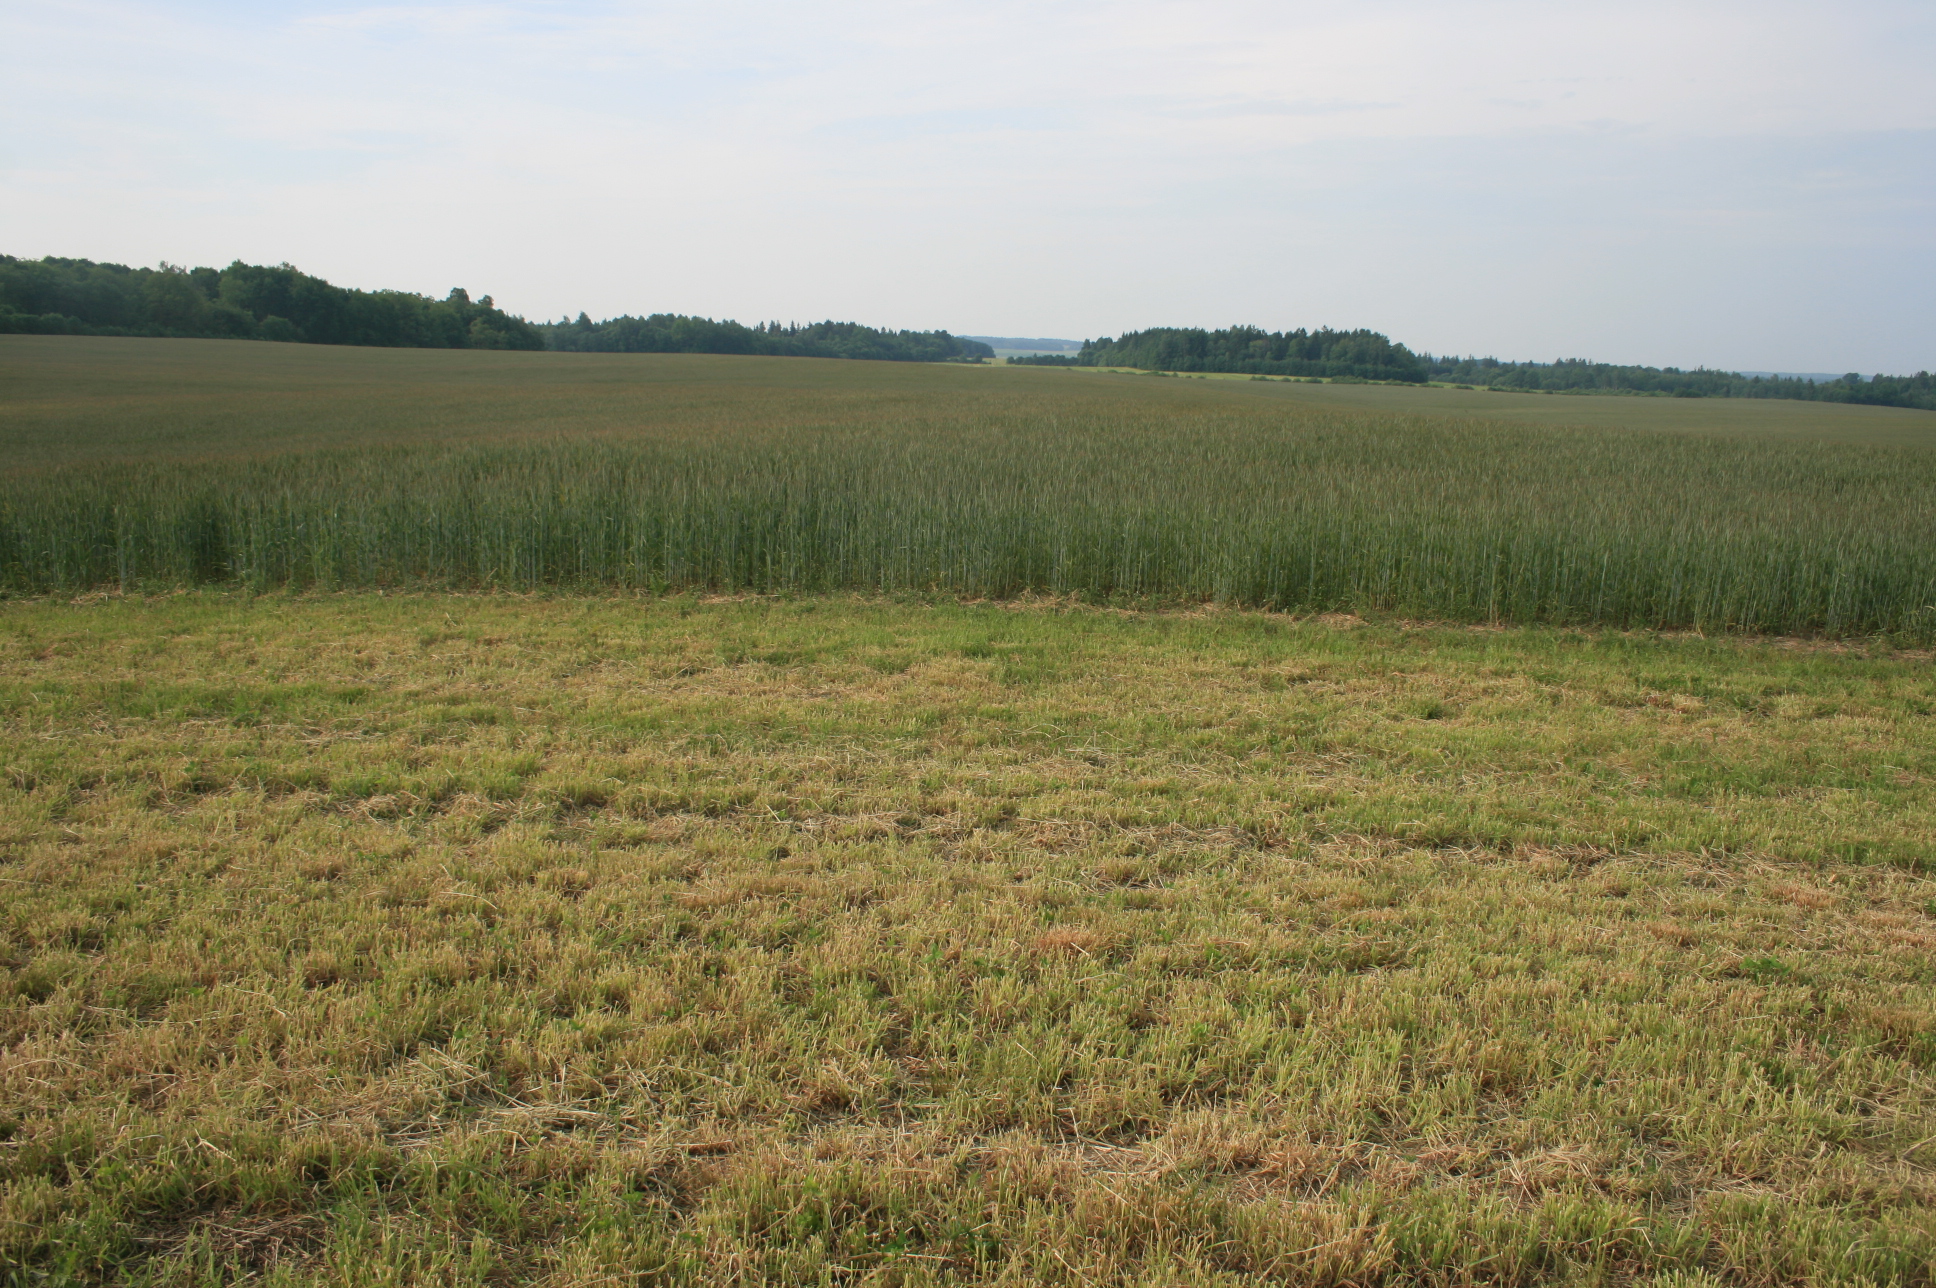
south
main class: Grassland
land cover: Grassland without tree/shrub cover
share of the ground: > 75 %
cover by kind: herbaceous plants 100 %
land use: Agriculture (excluding fallow land and kitchen gardens)
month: June
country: LT
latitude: 55.7269
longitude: 22.2367
